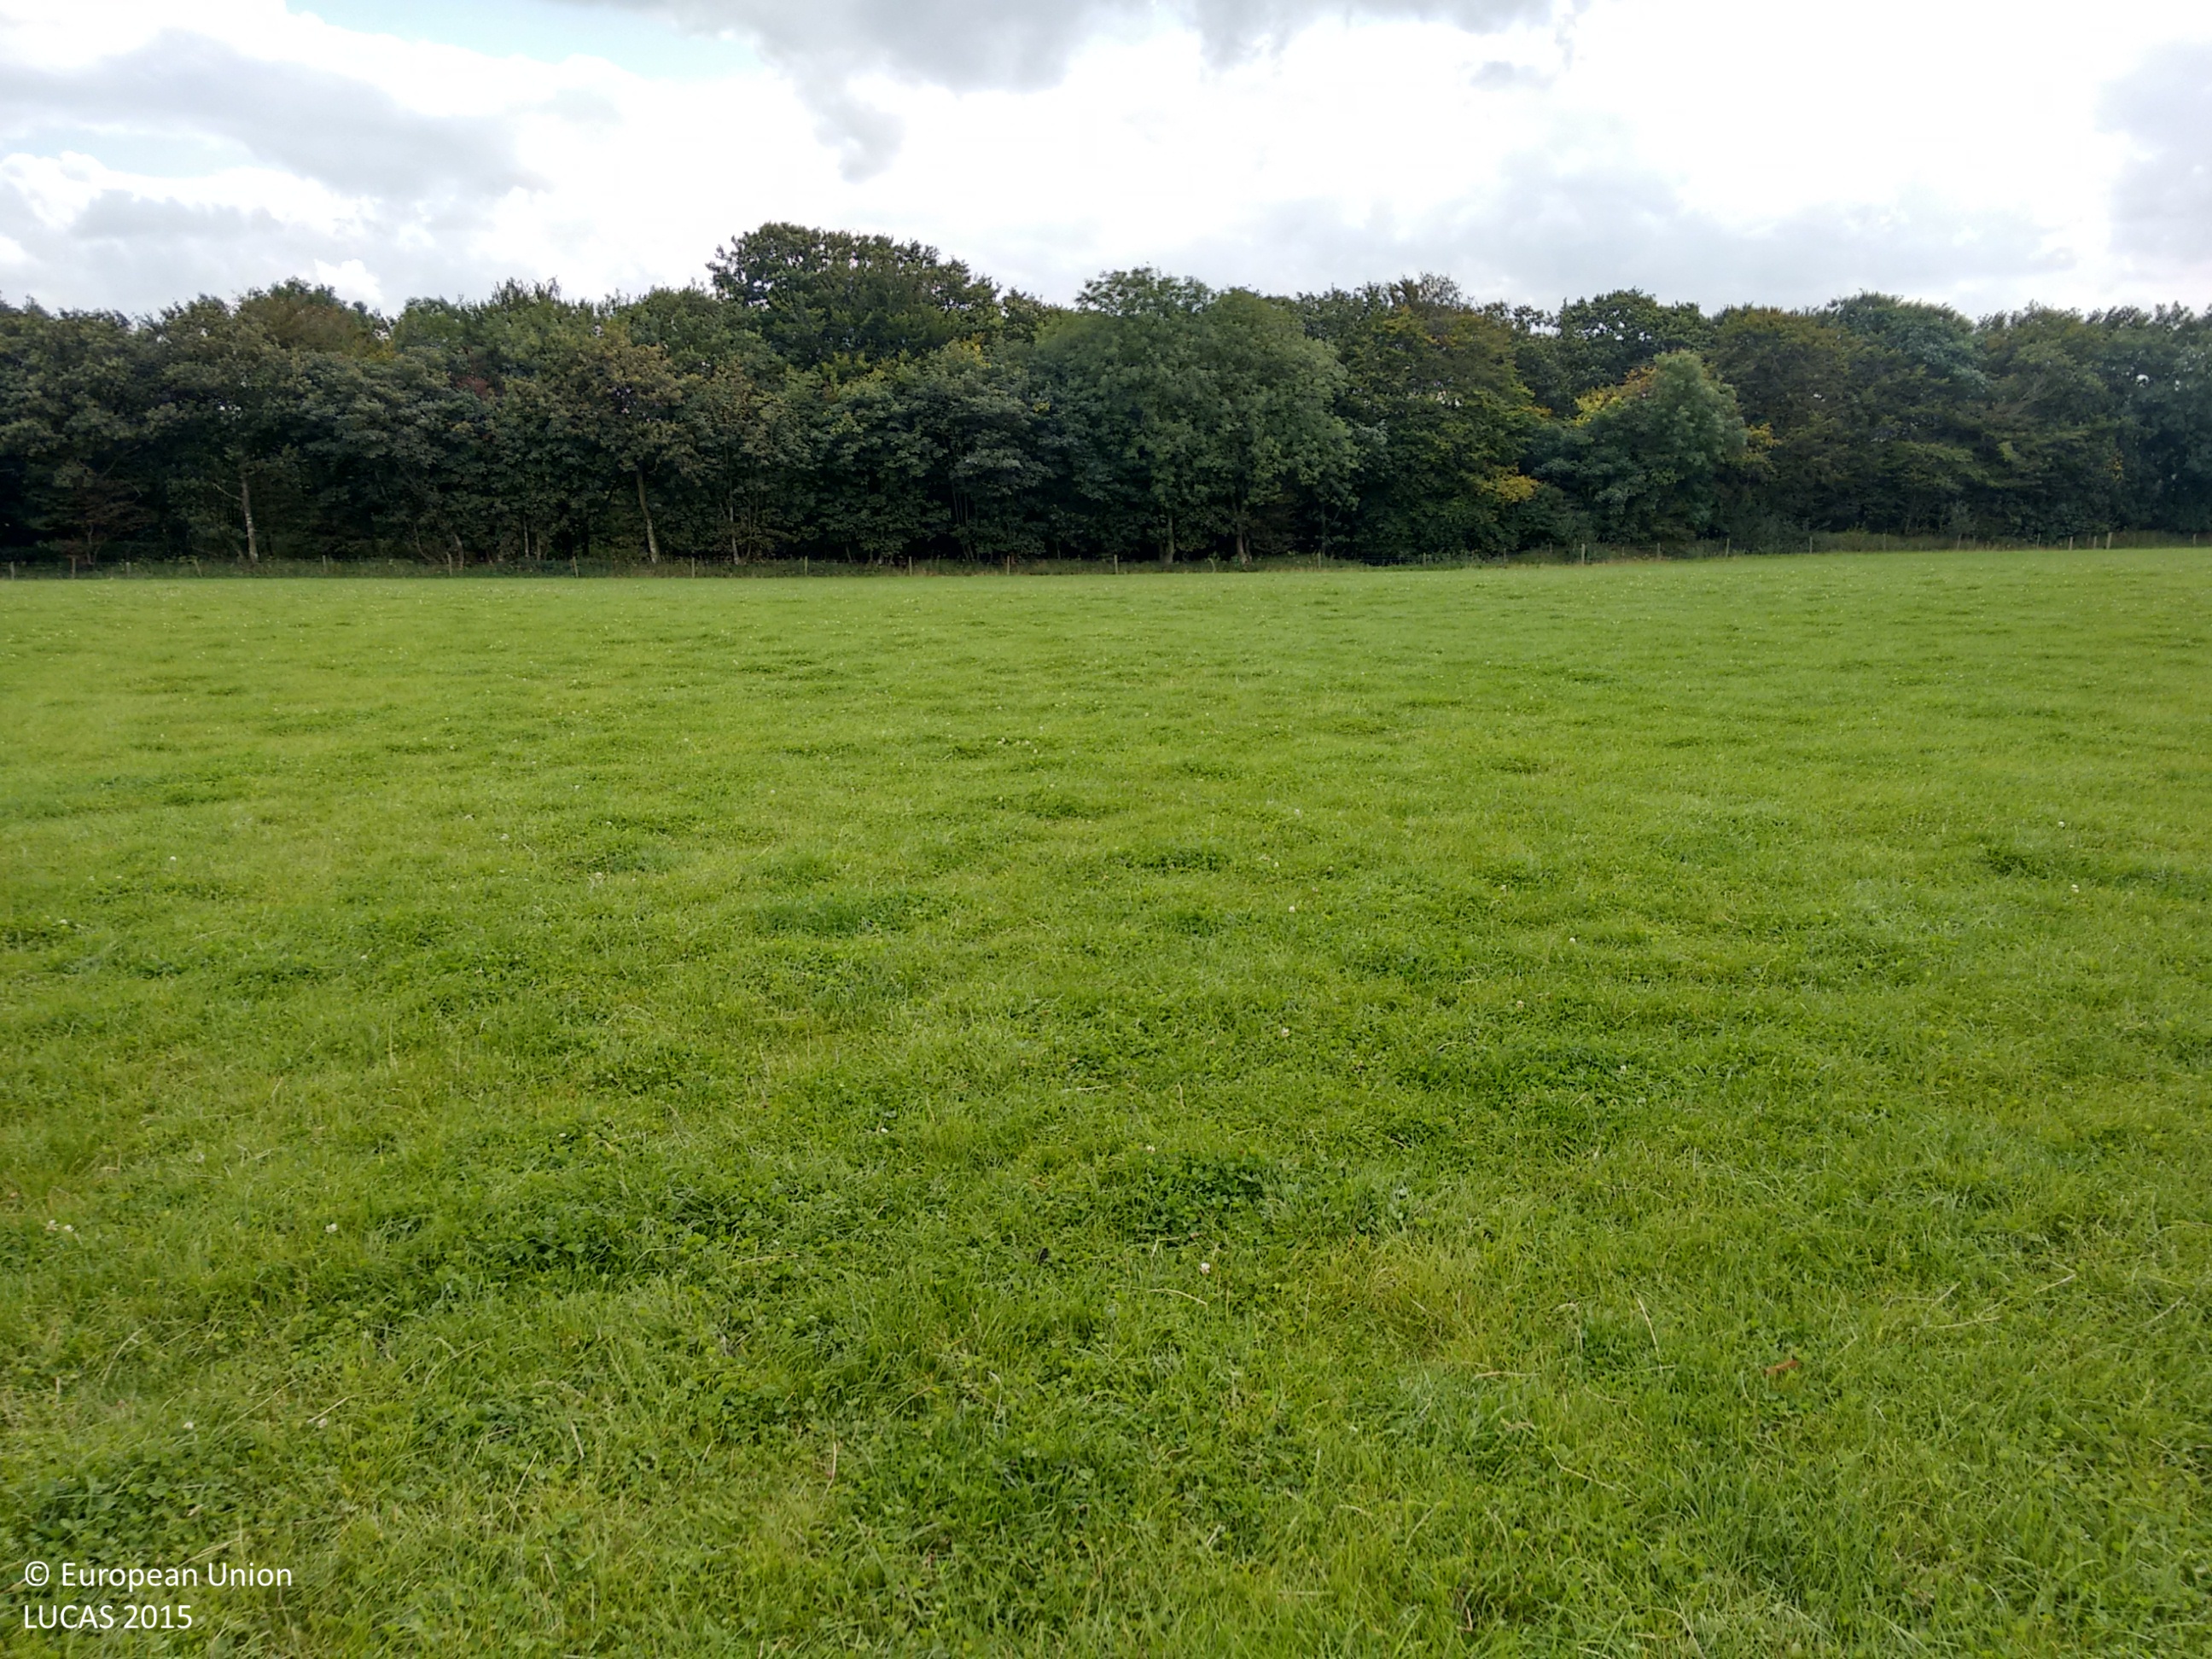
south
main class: Grassland
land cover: Grassland without tree/shrub cover
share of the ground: > 75 %
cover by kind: herbaceous plants 100 %
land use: Agriculture (excluding fallow land and kitchen gardens)
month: September
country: GB
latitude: 50.9195
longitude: -4.3116
